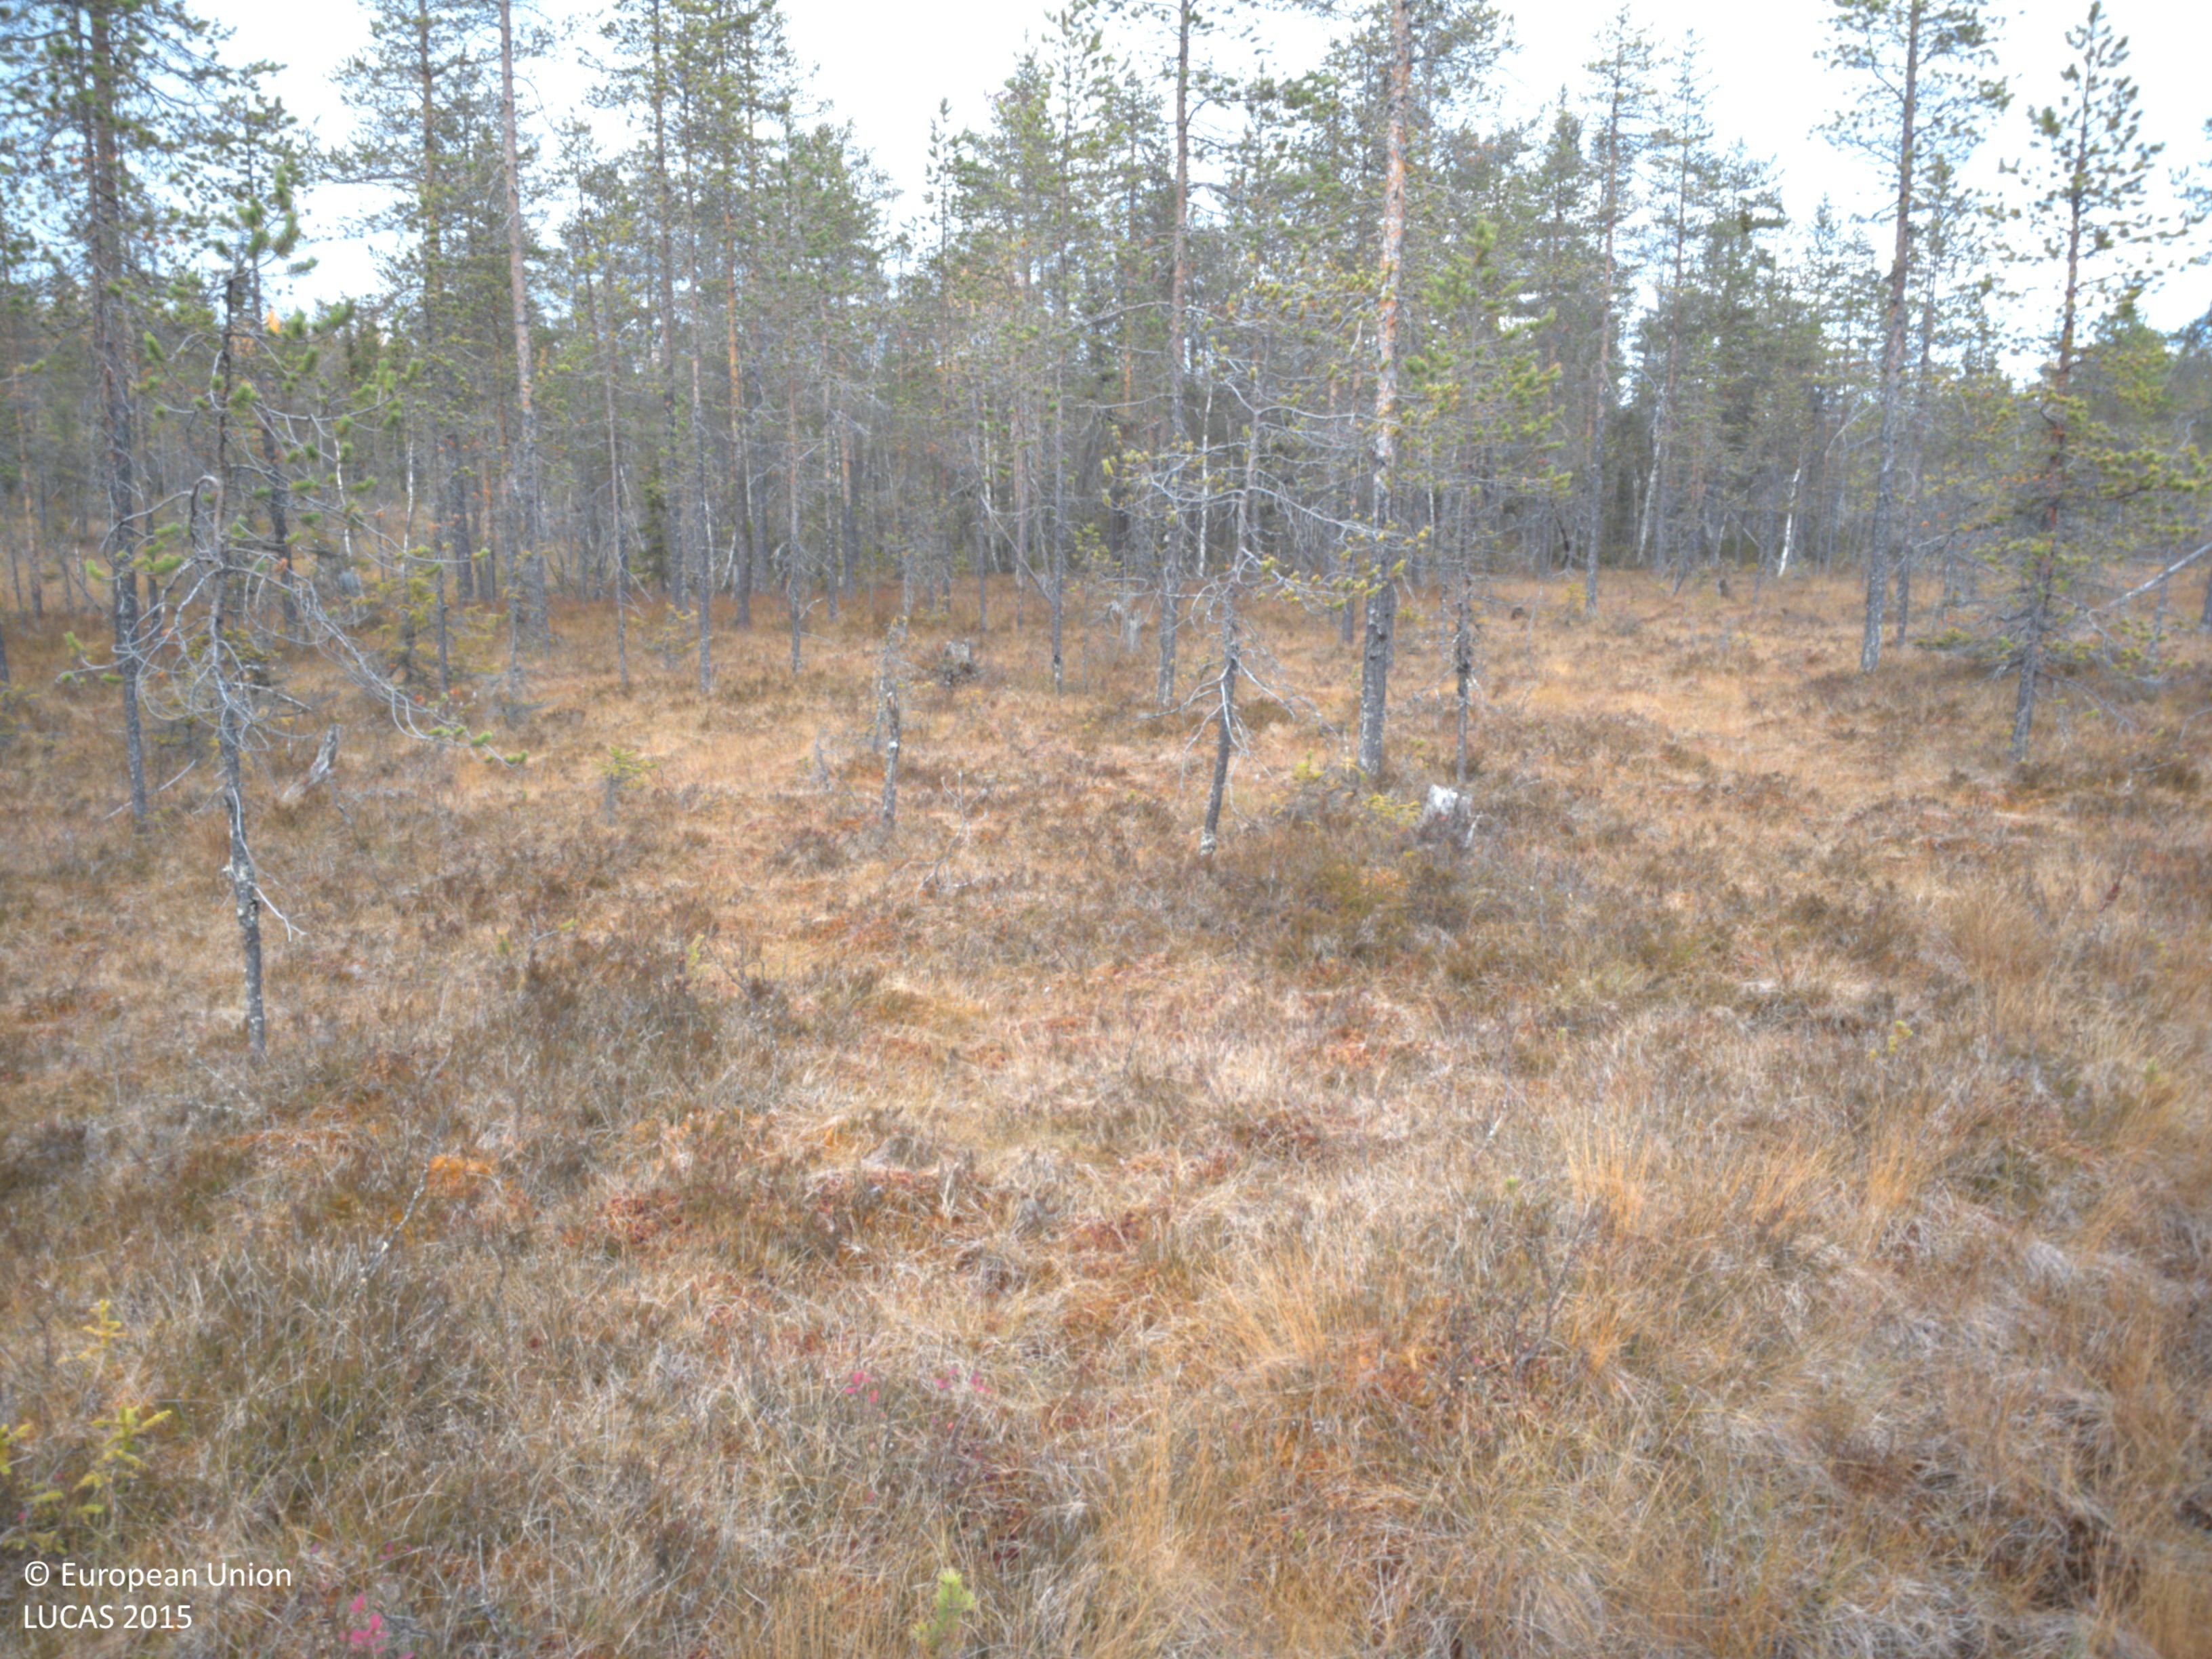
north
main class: Woodland
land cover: Pine dominated coniferous woodland
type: mire and swamp forests
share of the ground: 10 - 25 %
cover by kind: coniferous forest trees 30 %, shrubs 30 %, herbaceous plants 30 %, lichens and mosses 10 %
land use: Semi-natural and natural areas not in use
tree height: < 5 m
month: September
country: SE
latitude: 65.0015
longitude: 18.5961
